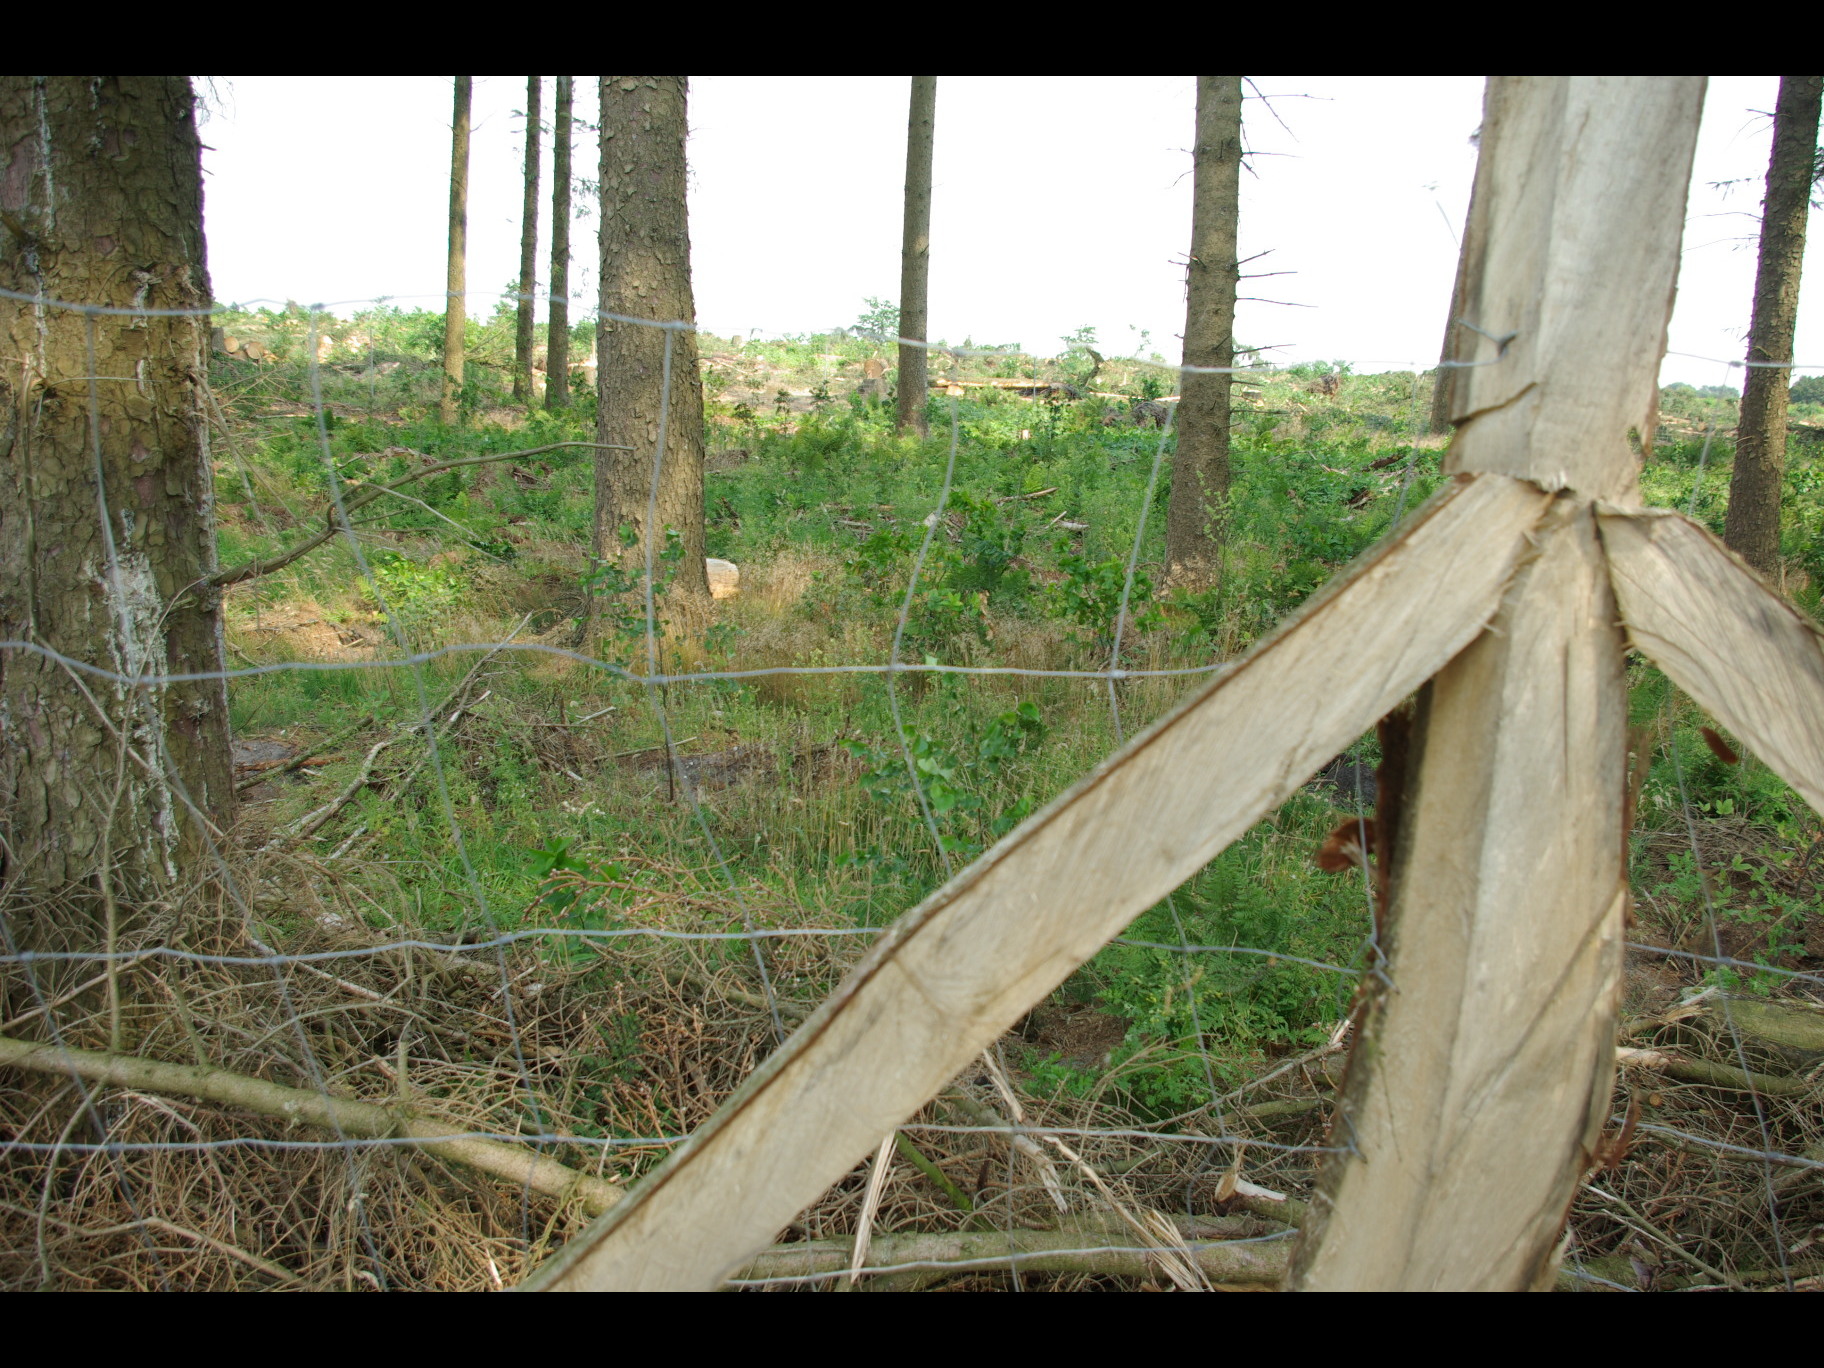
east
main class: Woodland
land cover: Spruce dominated coniferous woodland
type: hemiboreal forest and nemoral coniferous forest and mixed broadleaved-coniferous forest
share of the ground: 50 - 75 %
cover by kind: coniferous forest trees 60 %, herbaceous plants 30 %, unconsolidated bare surface 10 %
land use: Forestry
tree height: > 5 m
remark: Clear cut
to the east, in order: Spruce dominated coniferous woodland; Fences; Tracks; Spontaneously vegetated surfaces; Maize
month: August
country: DE
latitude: 54.5502
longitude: 9.3048
